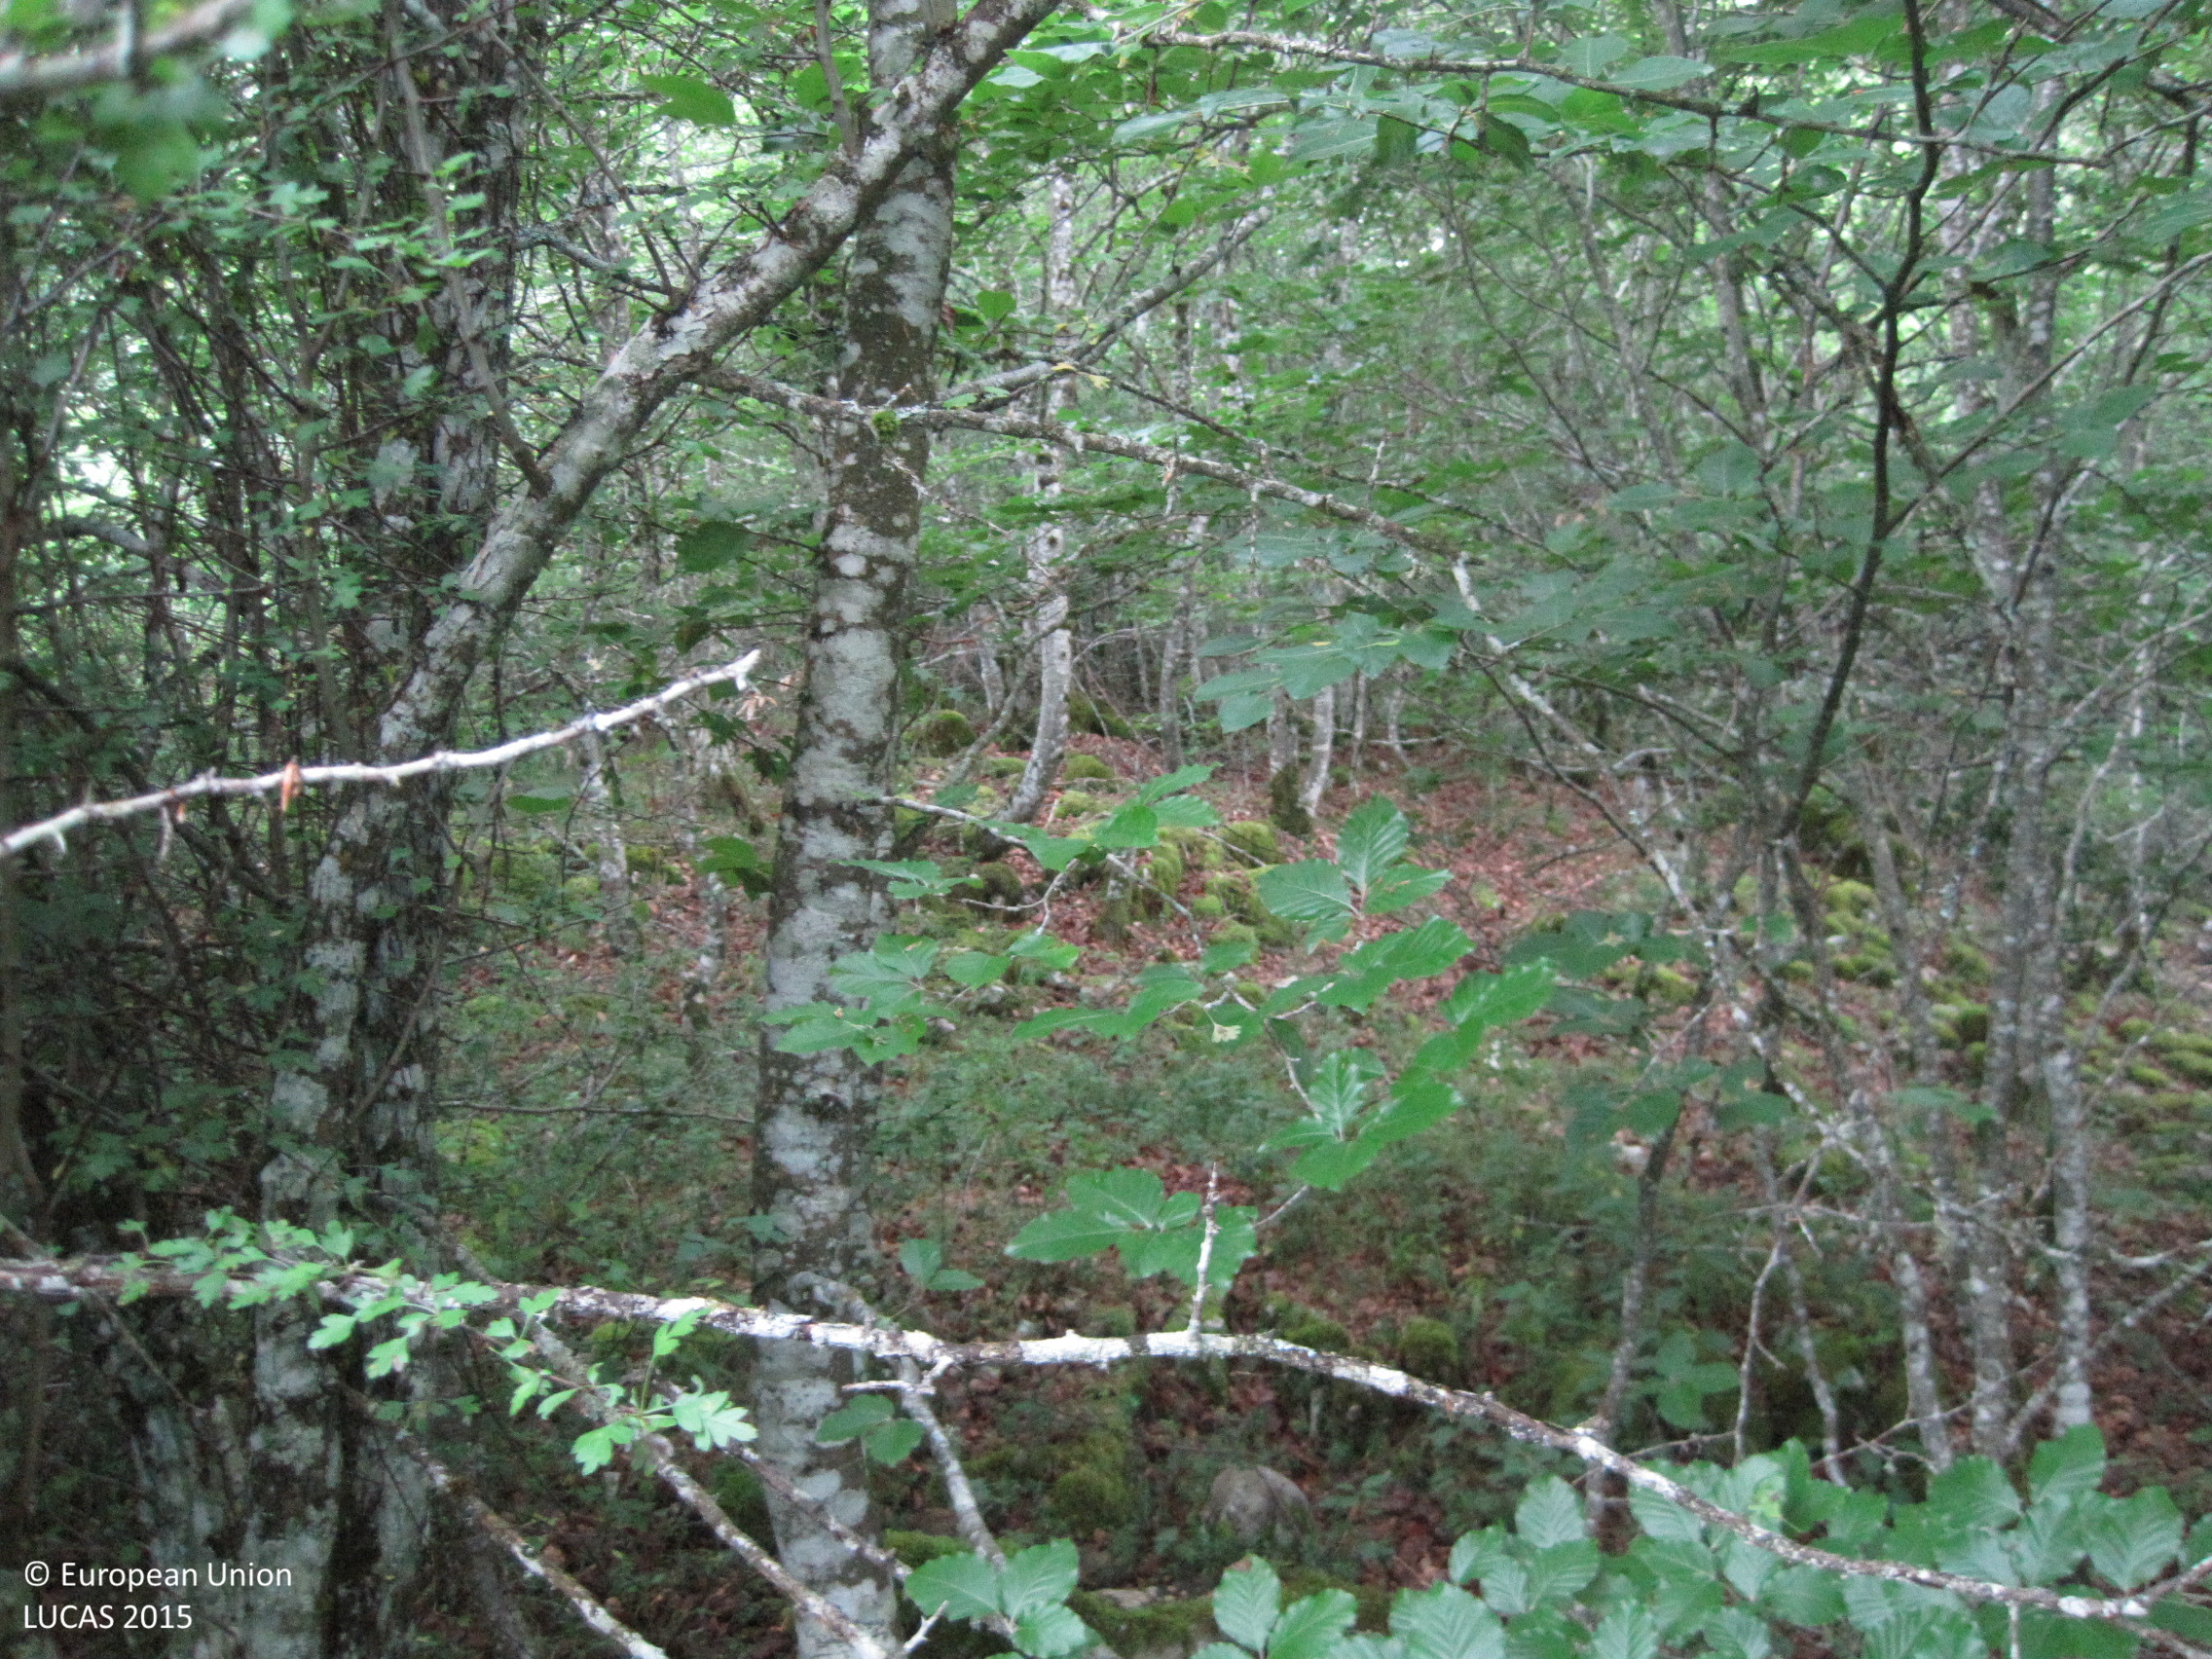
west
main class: Woodland
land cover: Broadleaved woodland
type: beech forest
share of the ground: > 75 %
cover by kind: broadleaved forest trees 100 %
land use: Forestry
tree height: > 5 m
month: June
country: ES
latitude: 42.7939
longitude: -2.1605
